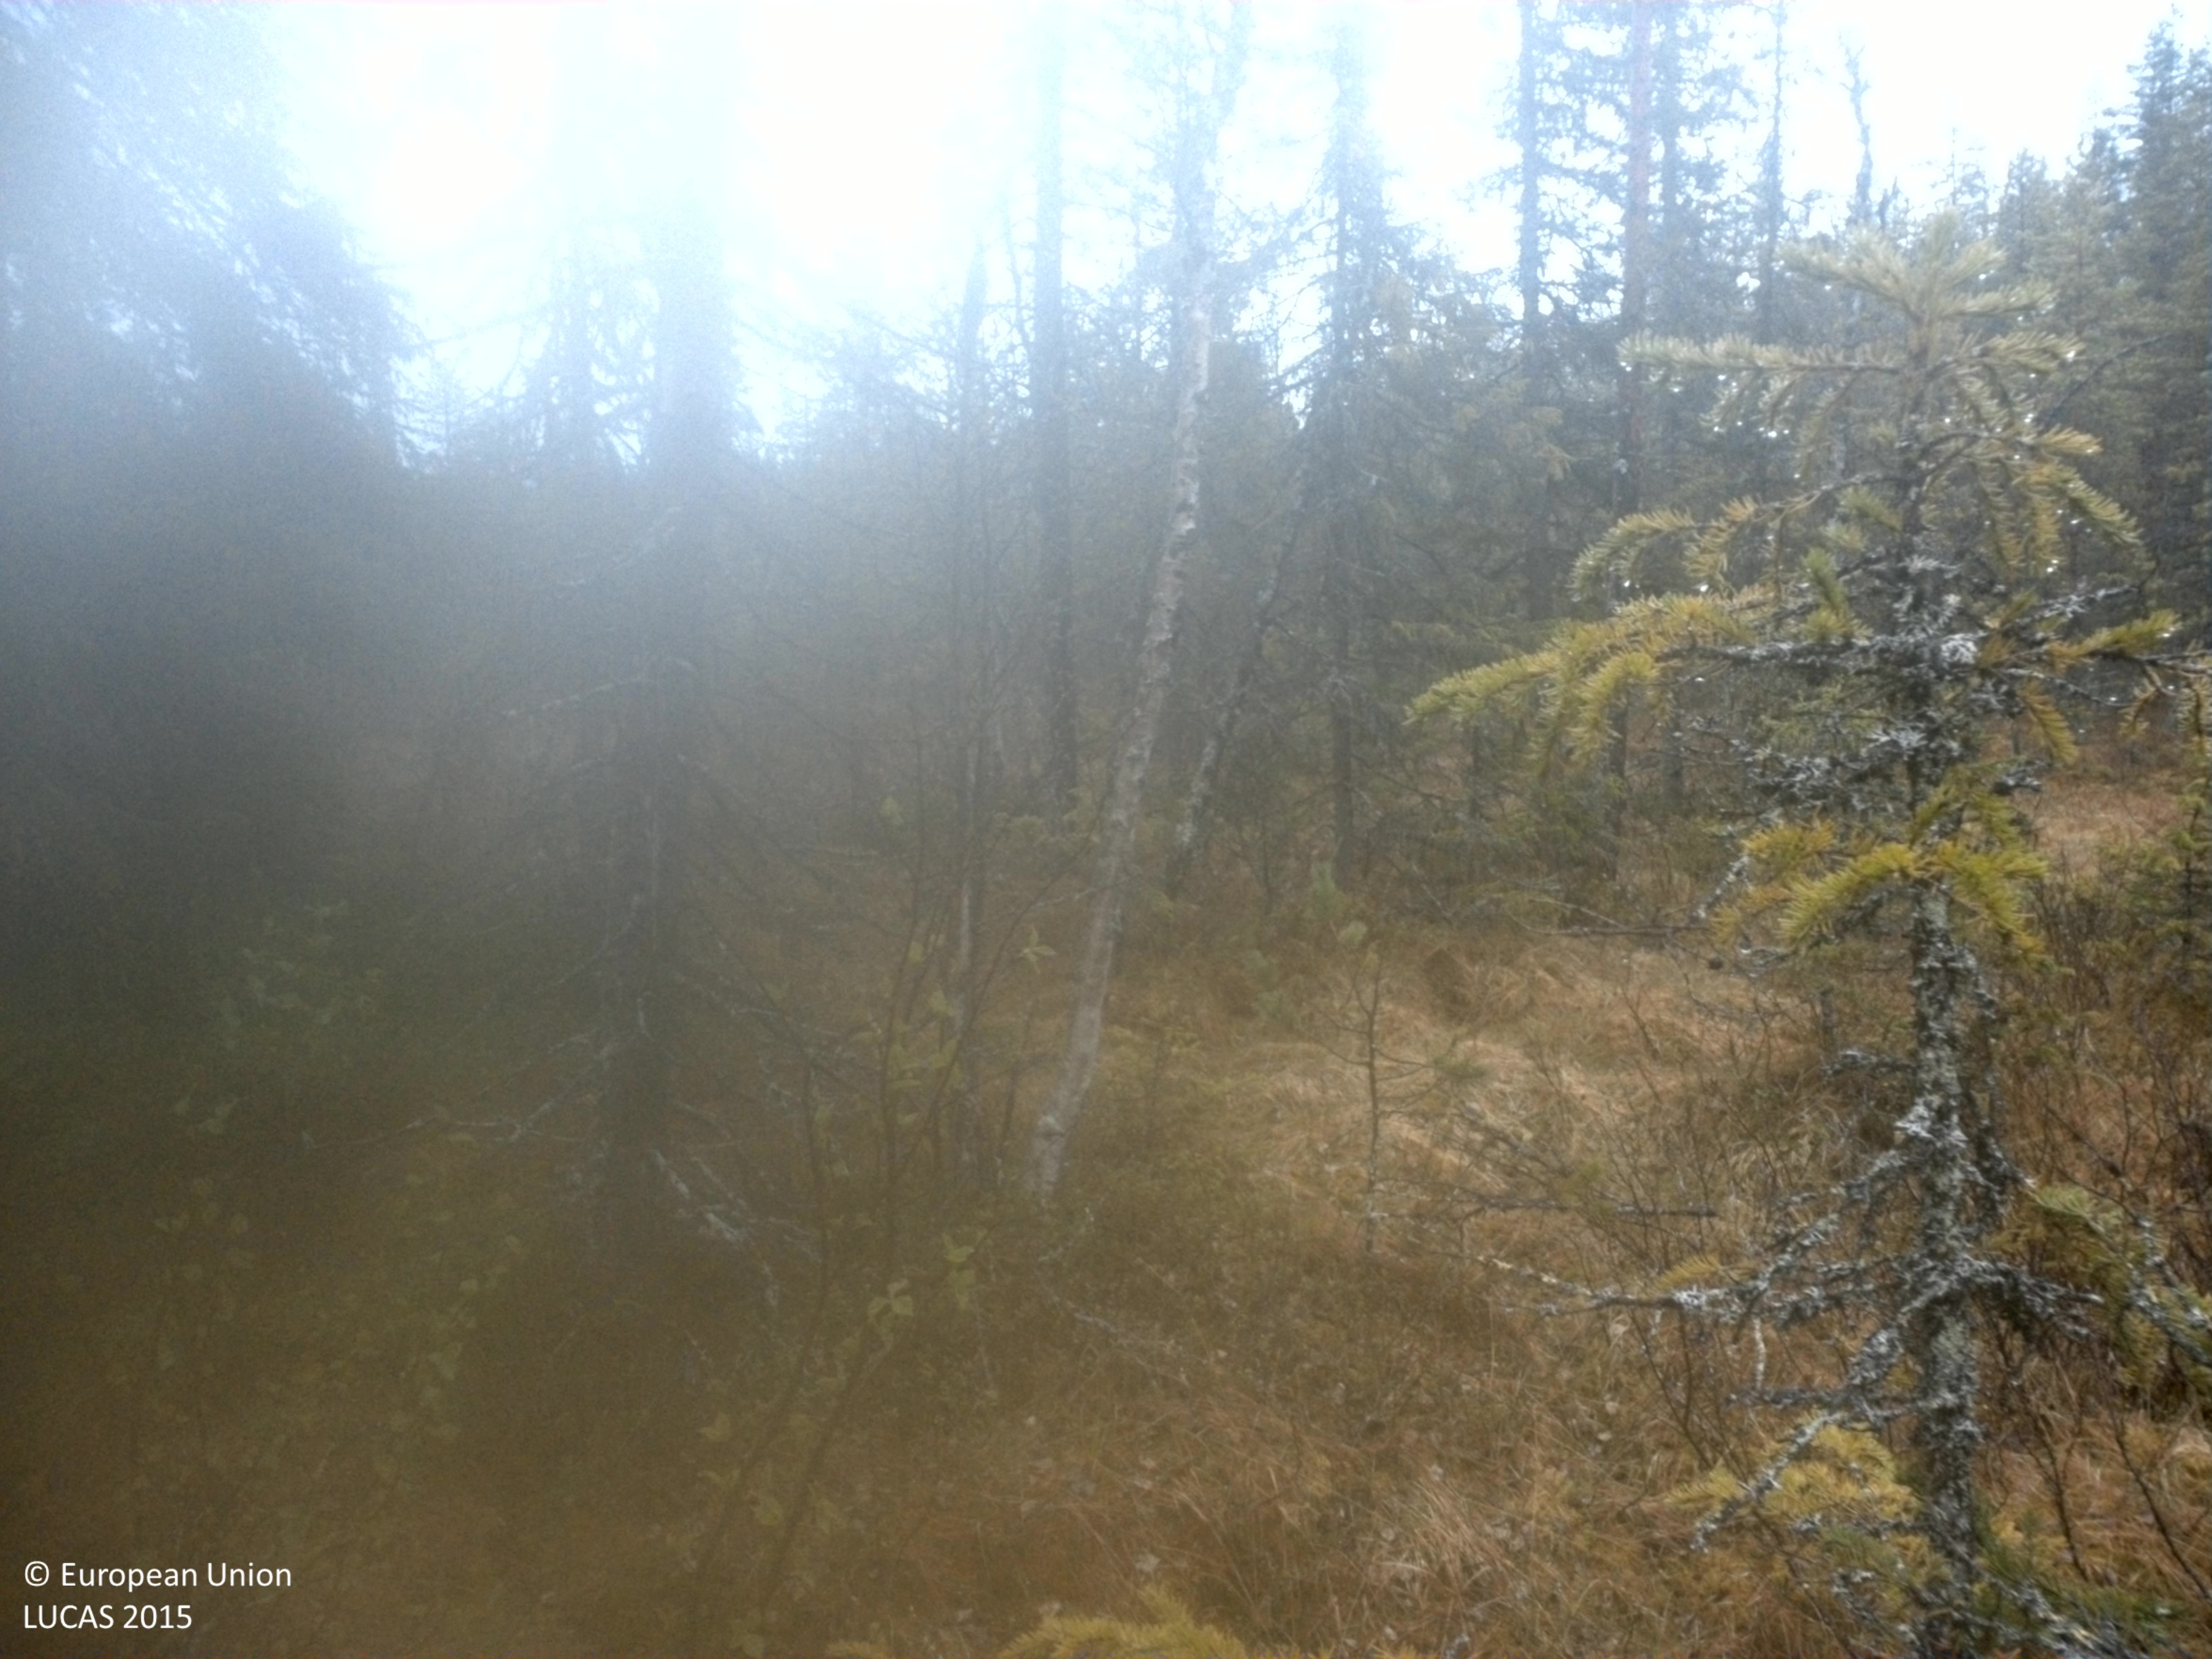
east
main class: Woodland
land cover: Spruce dominated mixed woodland
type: boreal forest
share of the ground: 25 - 50 %
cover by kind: lichens and mosses 35 %, coniferous forest trees 30 %, herbaceous plants 20 %, broadleaved forest trees 10 %, shrubs 5 %
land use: Forestry
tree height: > 5 m
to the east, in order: Spruce dominated mixed woodland; Peatbogs; Pine dominated coniferous woodland
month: June
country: SE
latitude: 64.3185
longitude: 18.0968
